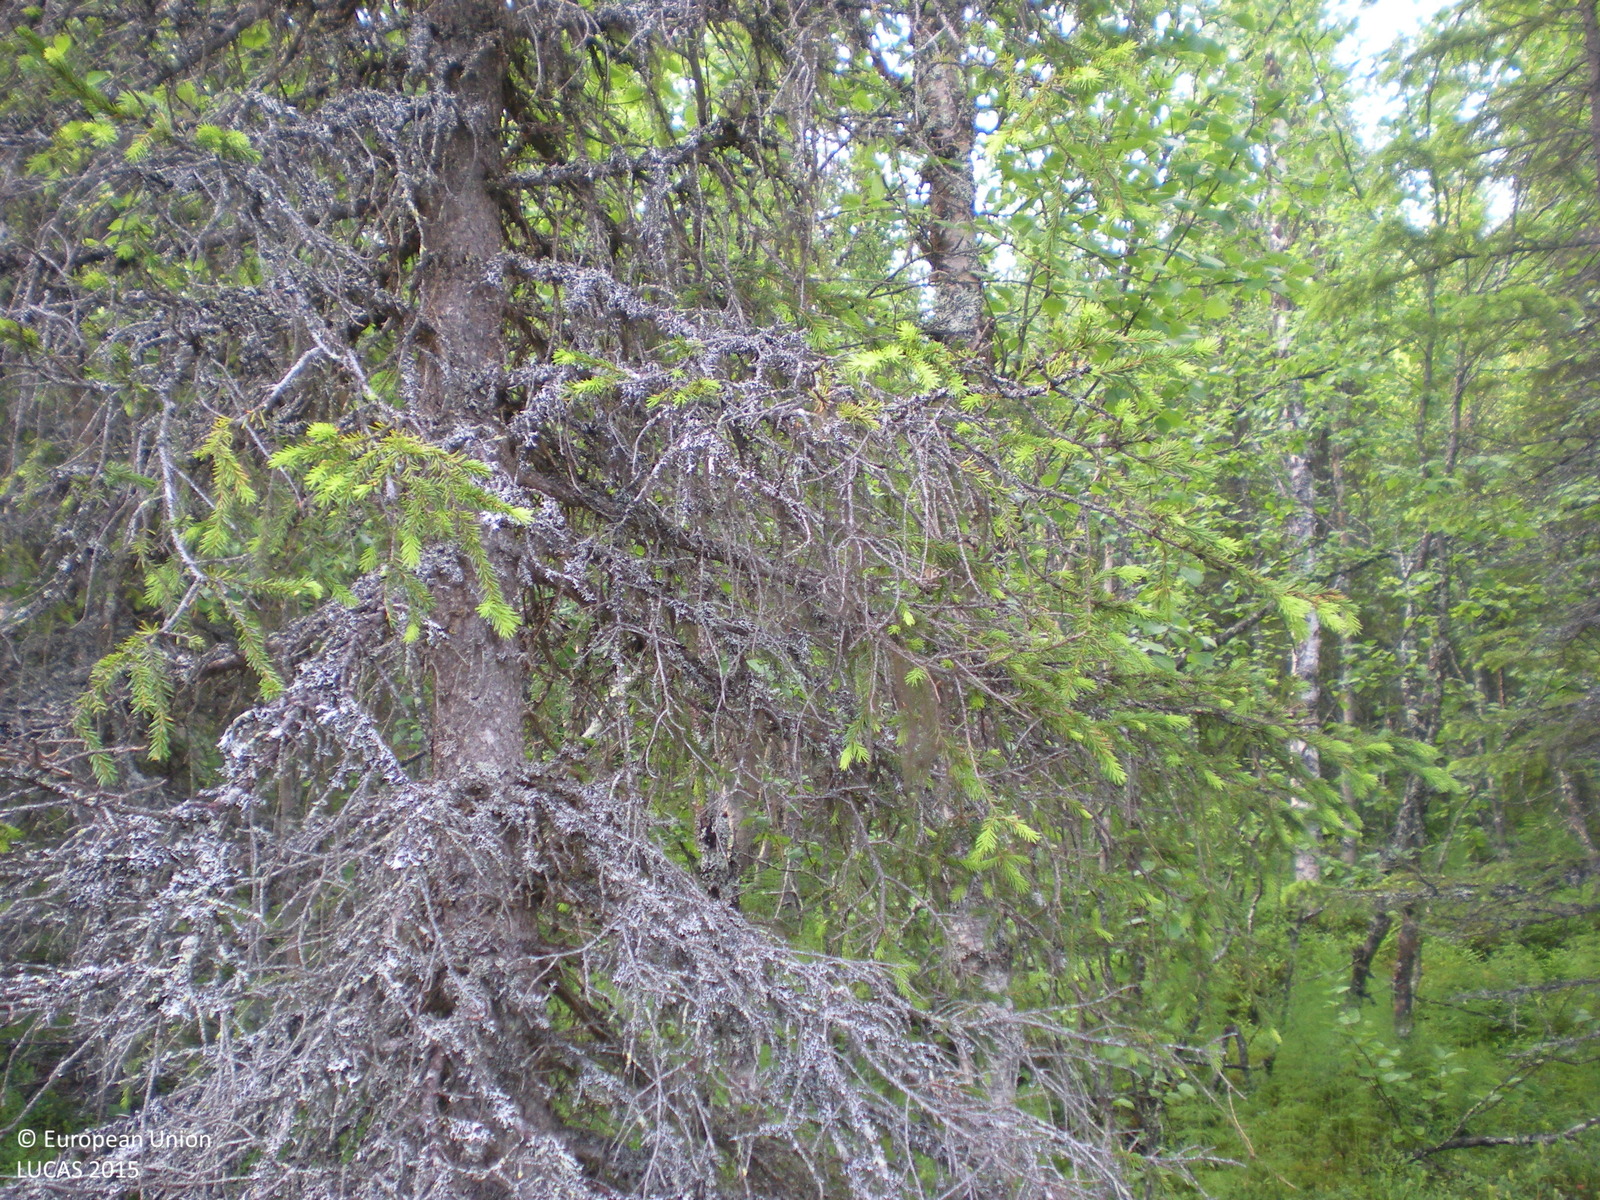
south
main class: Woodland
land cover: Spruce dominated mixed woodland
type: boreal forest
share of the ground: 50 - 75 %
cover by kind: coniferous forest trees 45 %, broadleaved forest trees 25 %, shrubs 20 %, lichens and mosses 10 %
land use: Forestry
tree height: > 5 m
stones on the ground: > 50 %
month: July
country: SE
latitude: 65.4911
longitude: 17.1112
